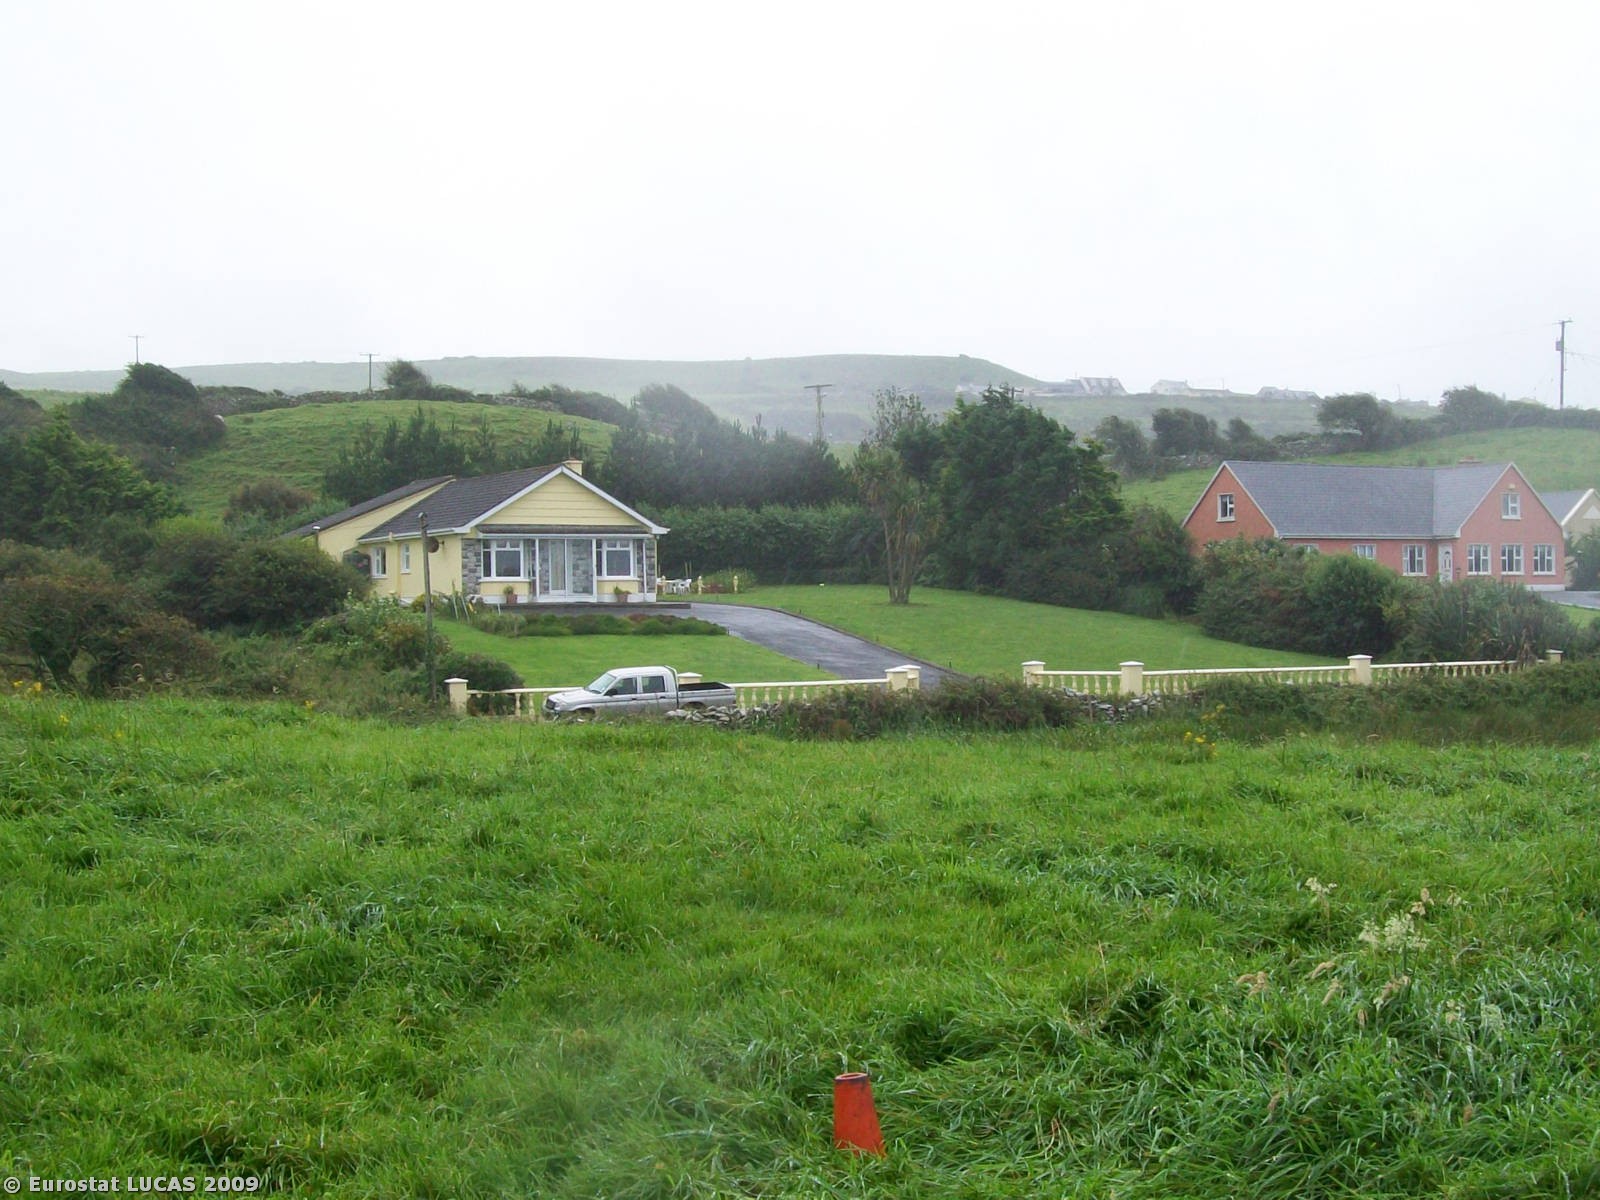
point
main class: Grassland
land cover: Grassland without tree/shrub cover
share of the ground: > 75 %
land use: Agriculture (excluding fallow land and kitchen gardens)
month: August
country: IE
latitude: 52.9357
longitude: -9.3145
